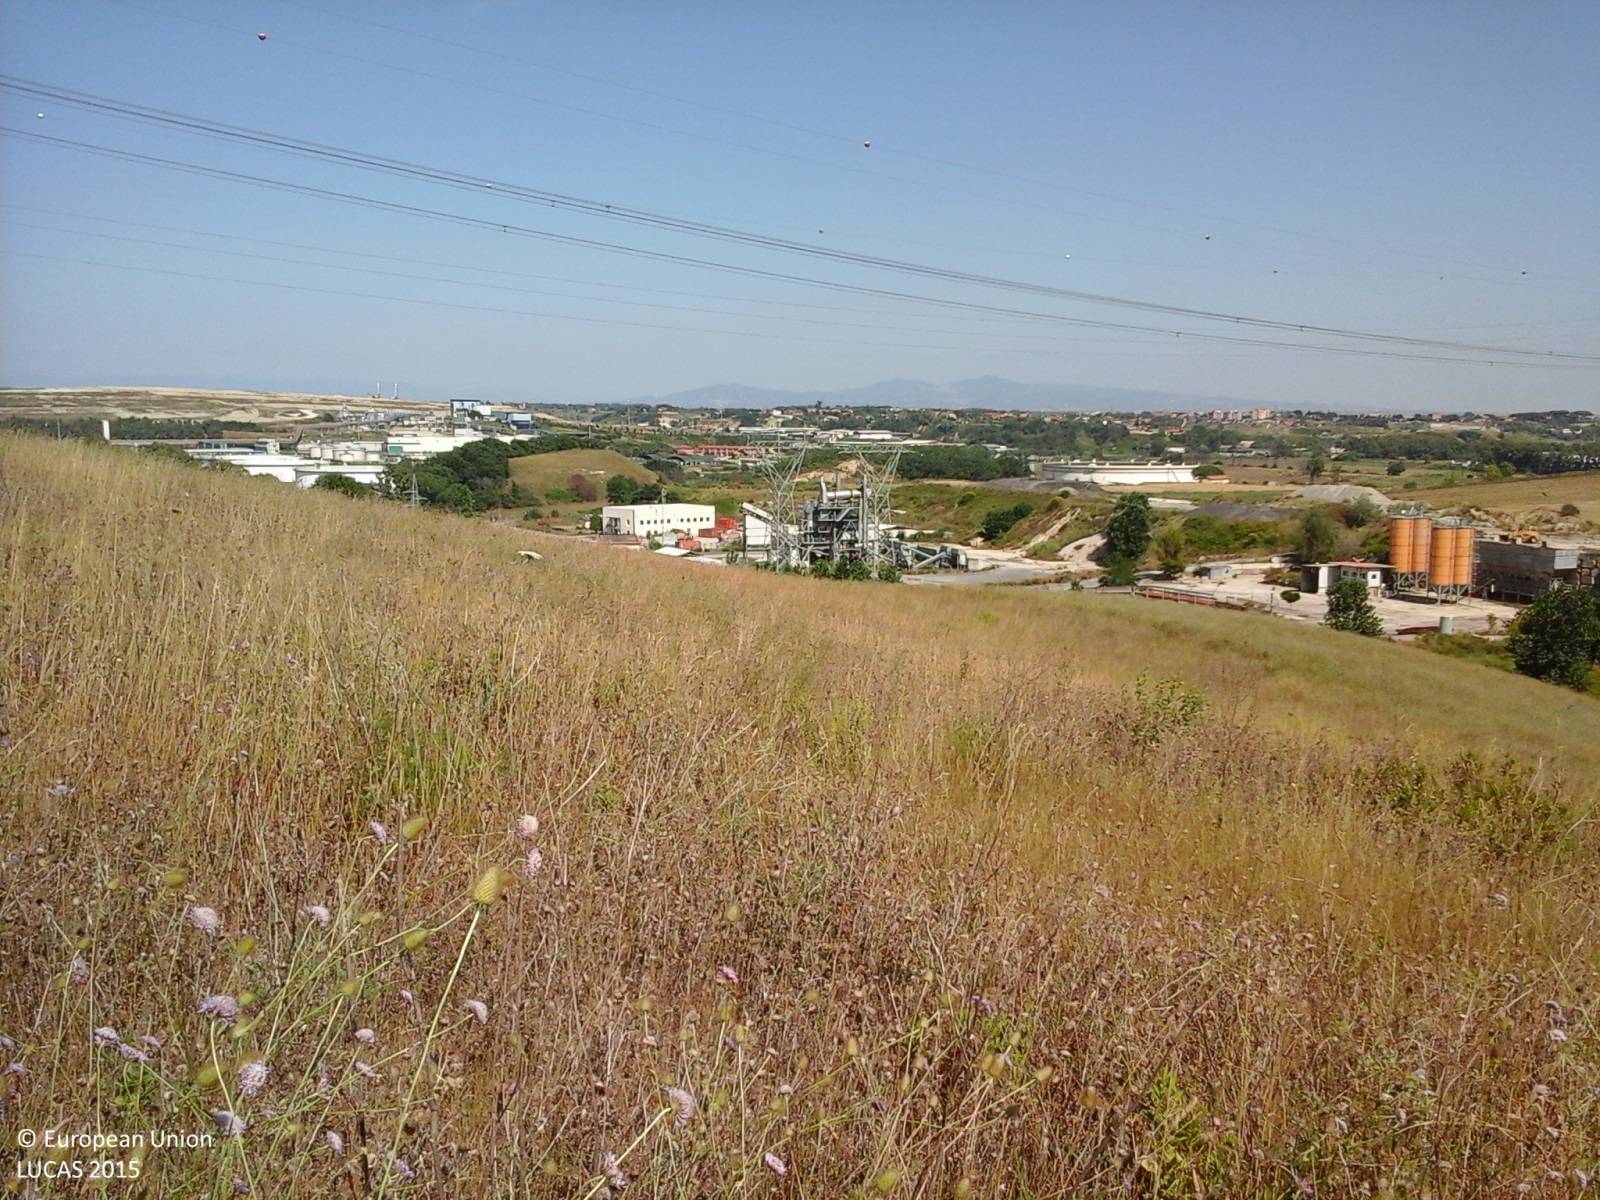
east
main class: Grassland
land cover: Grassland without tree/shrub cover
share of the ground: > 75 %
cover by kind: herbaceous plants 100 %
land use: Semi-natural and natural areas not in use
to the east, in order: Grassland without tree/shrub cover; Electric lines; Grassland without tree/shrub cover; Artificial constructions in urban areas
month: June
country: IT
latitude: 41.8504
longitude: 12.3158
